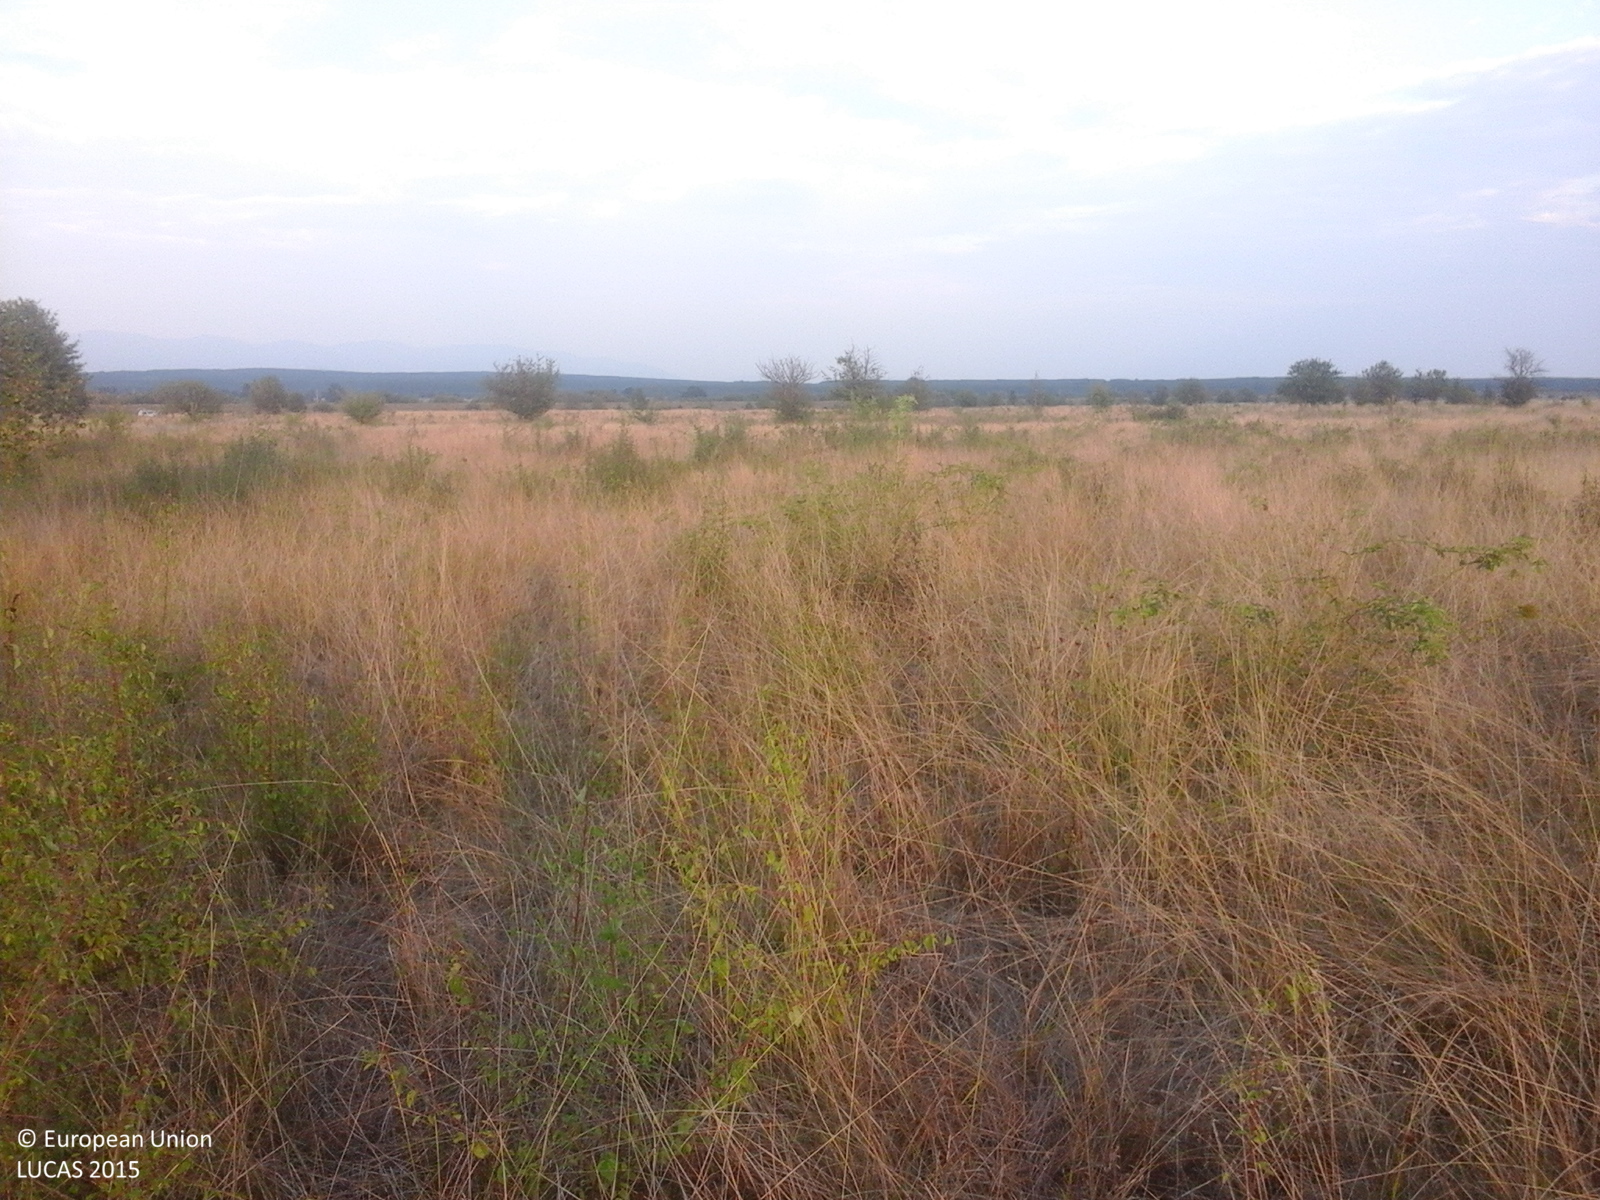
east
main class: Grassland
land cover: Grassland with sparse tree/shrub cover
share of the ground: > 75 %
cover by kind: herbaceous plants 85 %, shrubs 10 %, broadleaved forest trees 5 %
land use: Agriculture (excluding fallow land and kitchen gardens)
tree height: < 5 m
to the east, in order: Grassland with sparse tree/shrub cover; Ditches and canals; Grassland with sparse tree/shrub cover
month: August
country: RO
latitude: 46.5193
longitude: 21.9181
